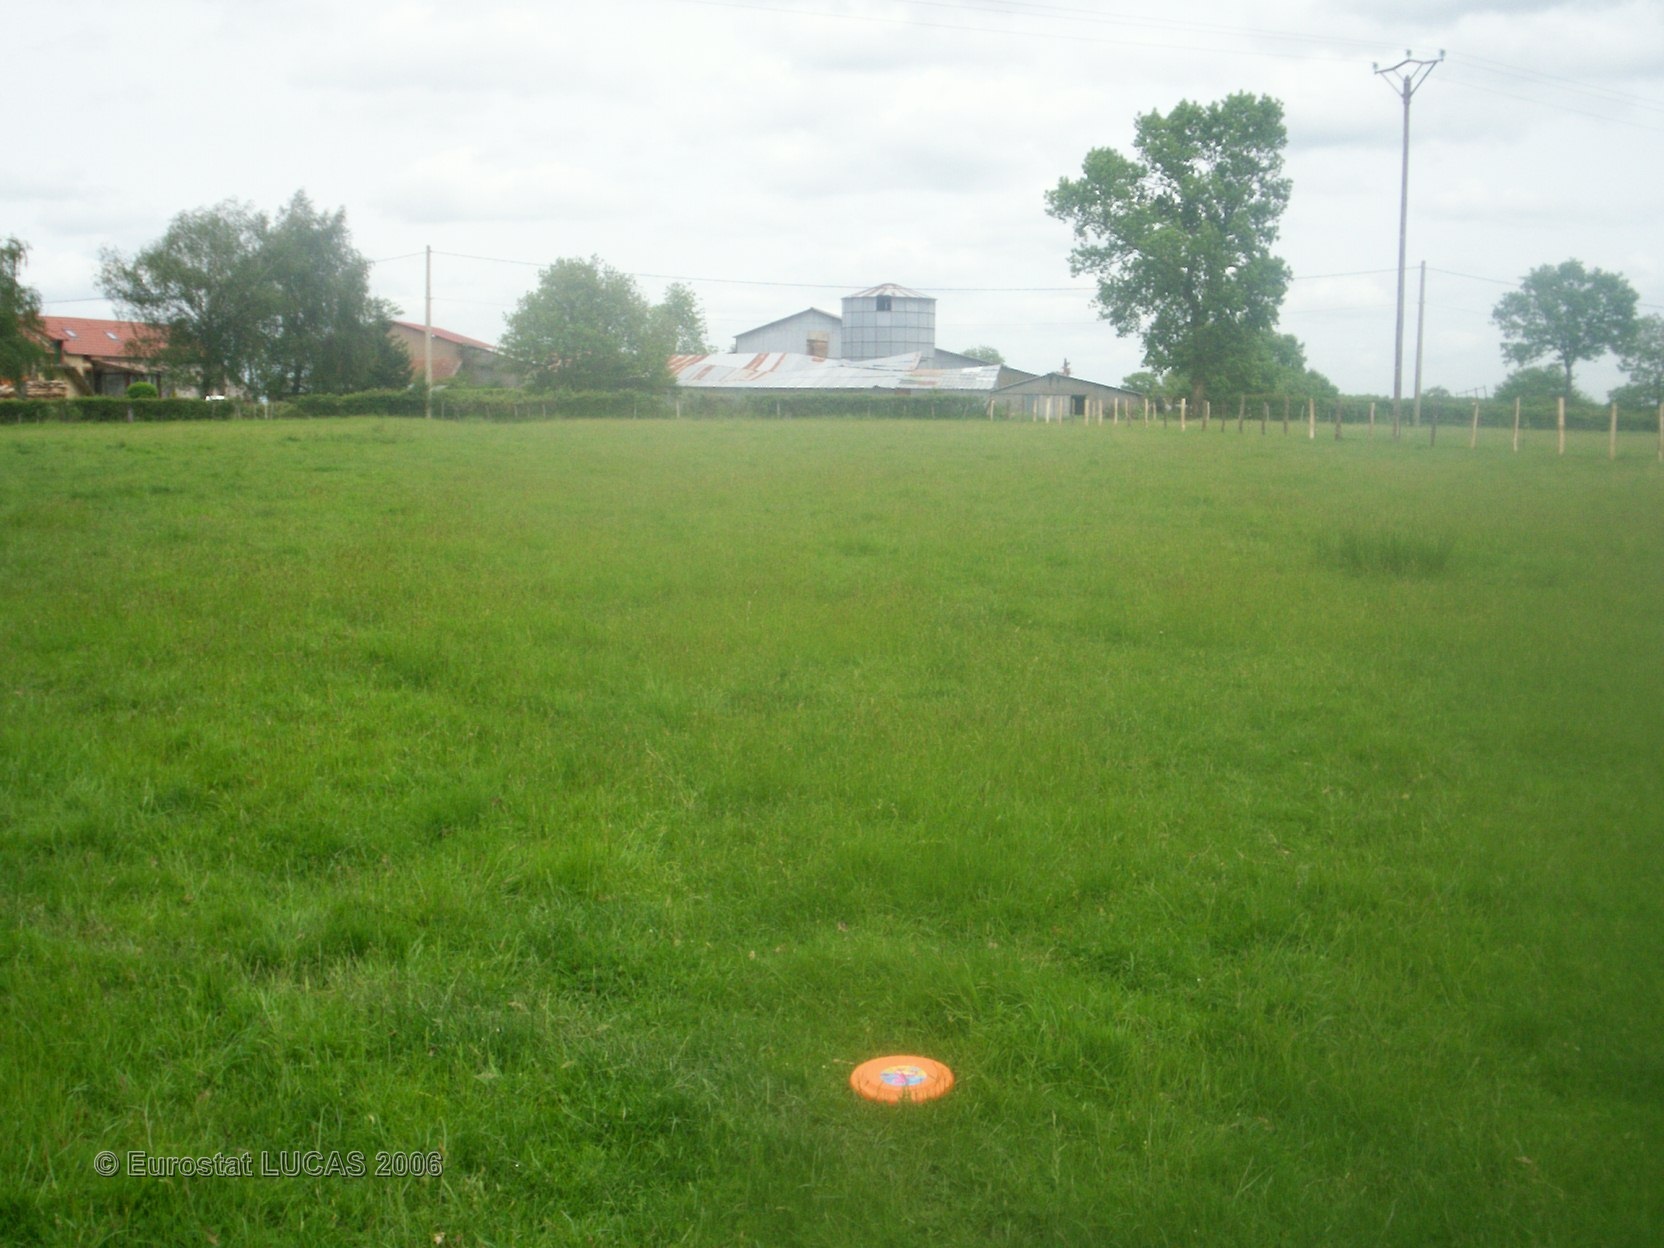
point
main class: Grassland
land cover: Grassland without tree/shrub cover
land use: Agriculture (excluding fallow land and kitchen gardens)
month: May
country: FR
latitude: 46.2044
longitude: 2.8824
